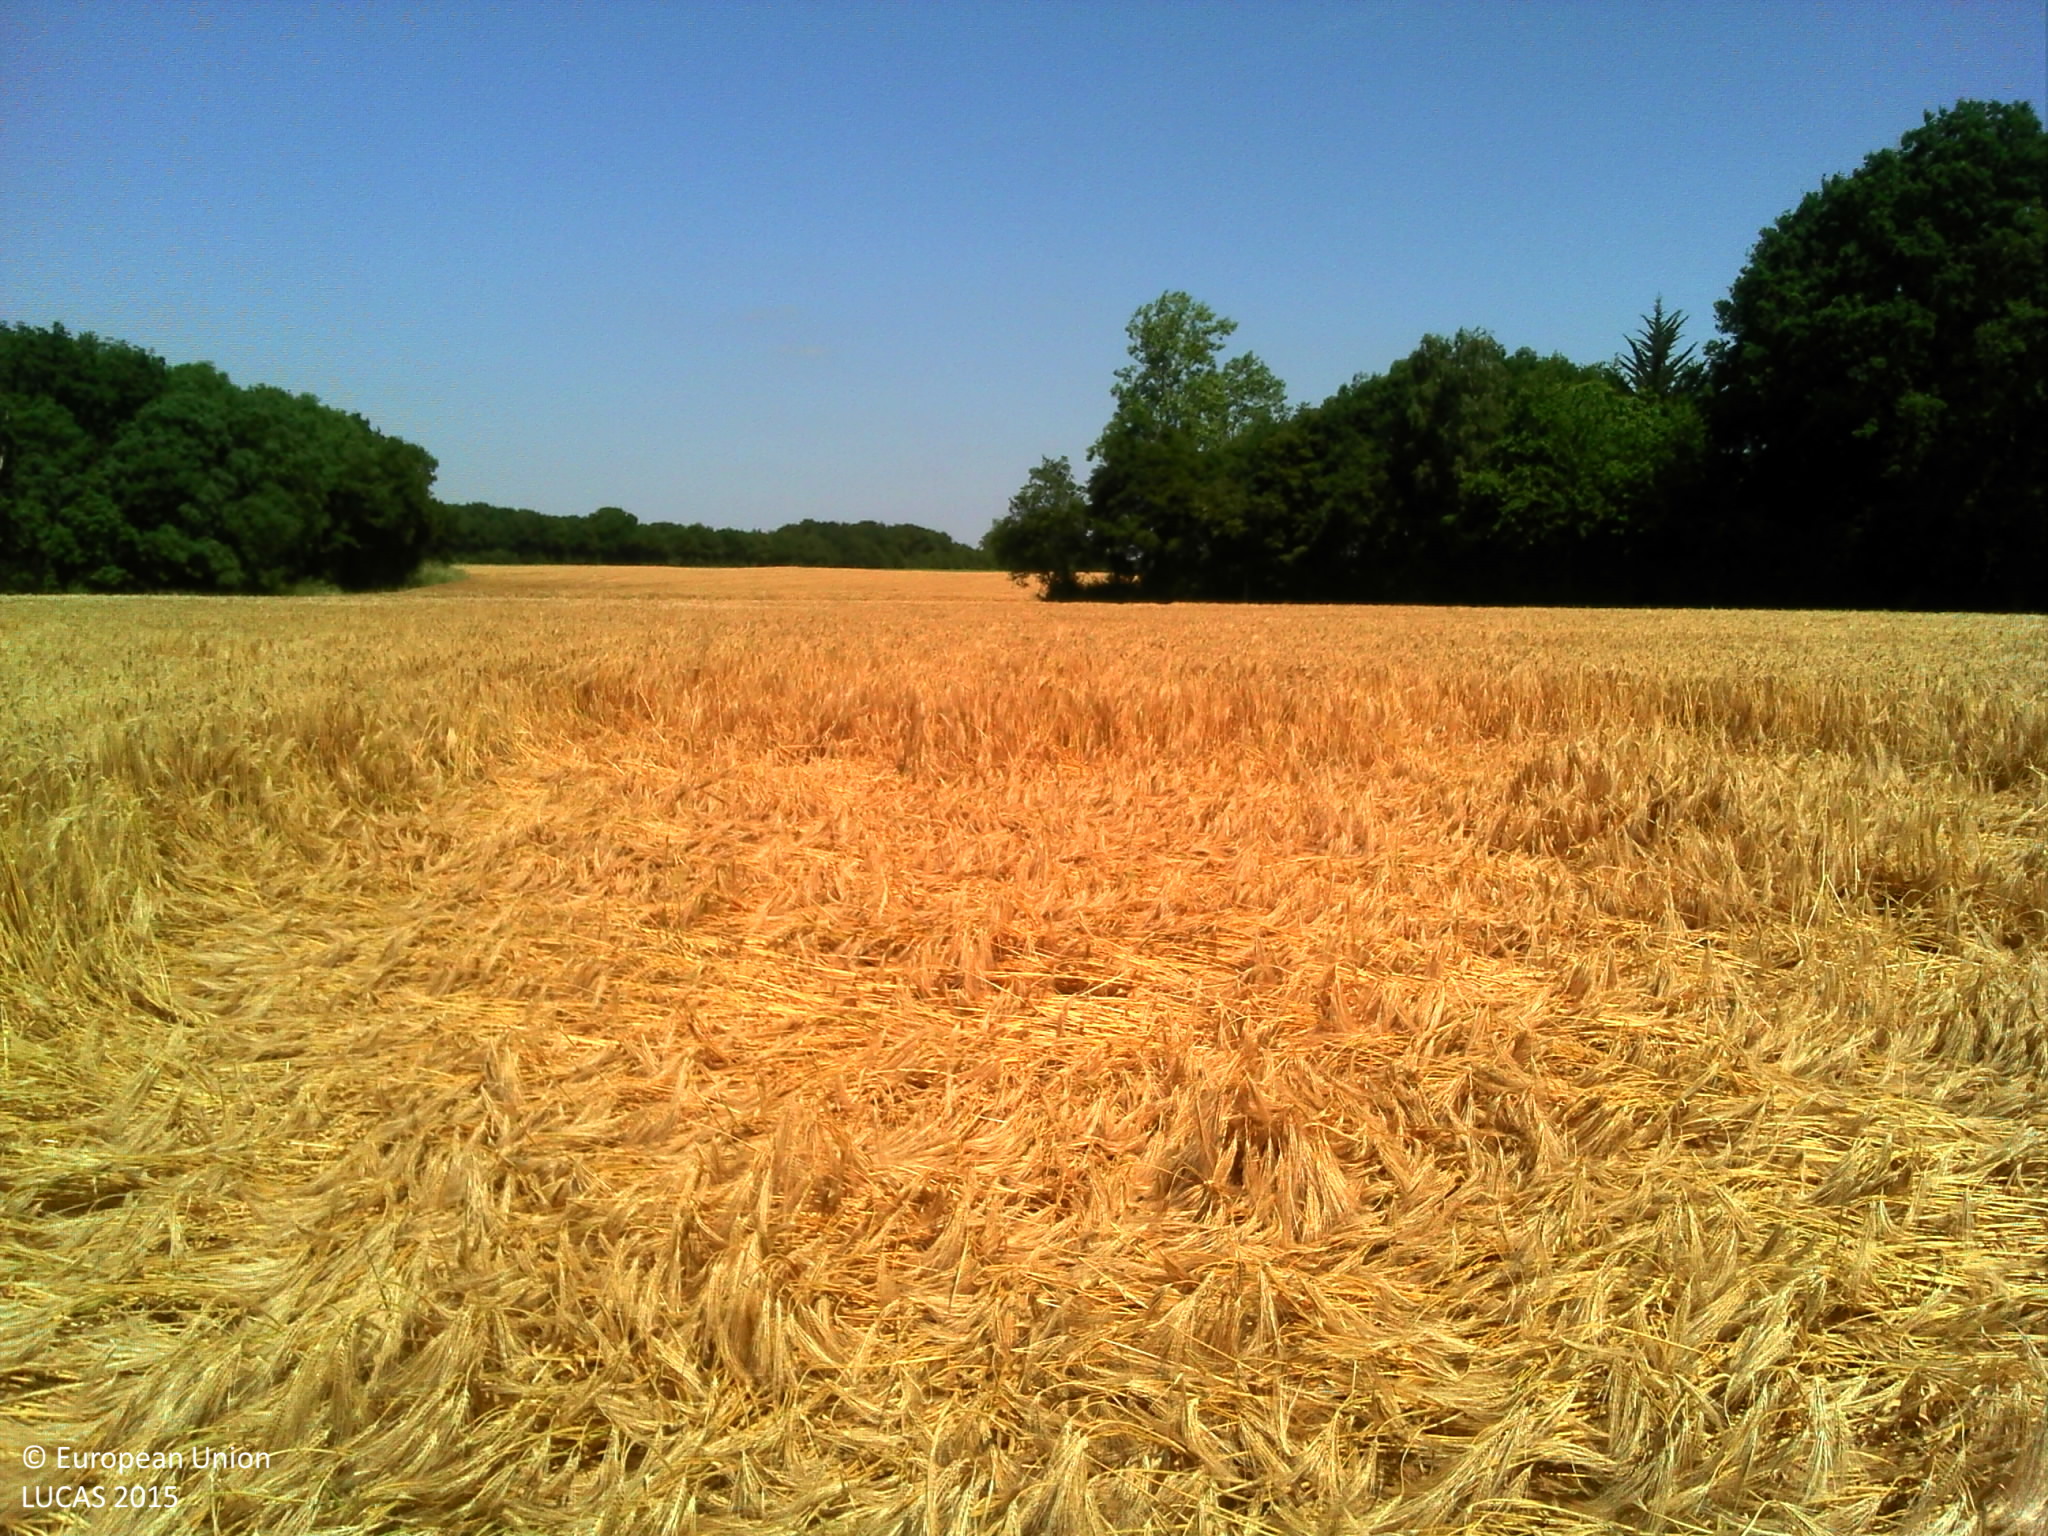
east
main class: Cropland
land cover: Barley
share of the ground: > 75 %
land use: Agriculture (excluding fallow land and kitchen gardens)
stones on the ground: < 10 %
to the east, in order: Barley; Broadleaved woodland; Ditches and canals; Grassland without tree/shrub cover; Barley
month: June
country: FR
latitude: 46.8504
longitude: -1.3823
